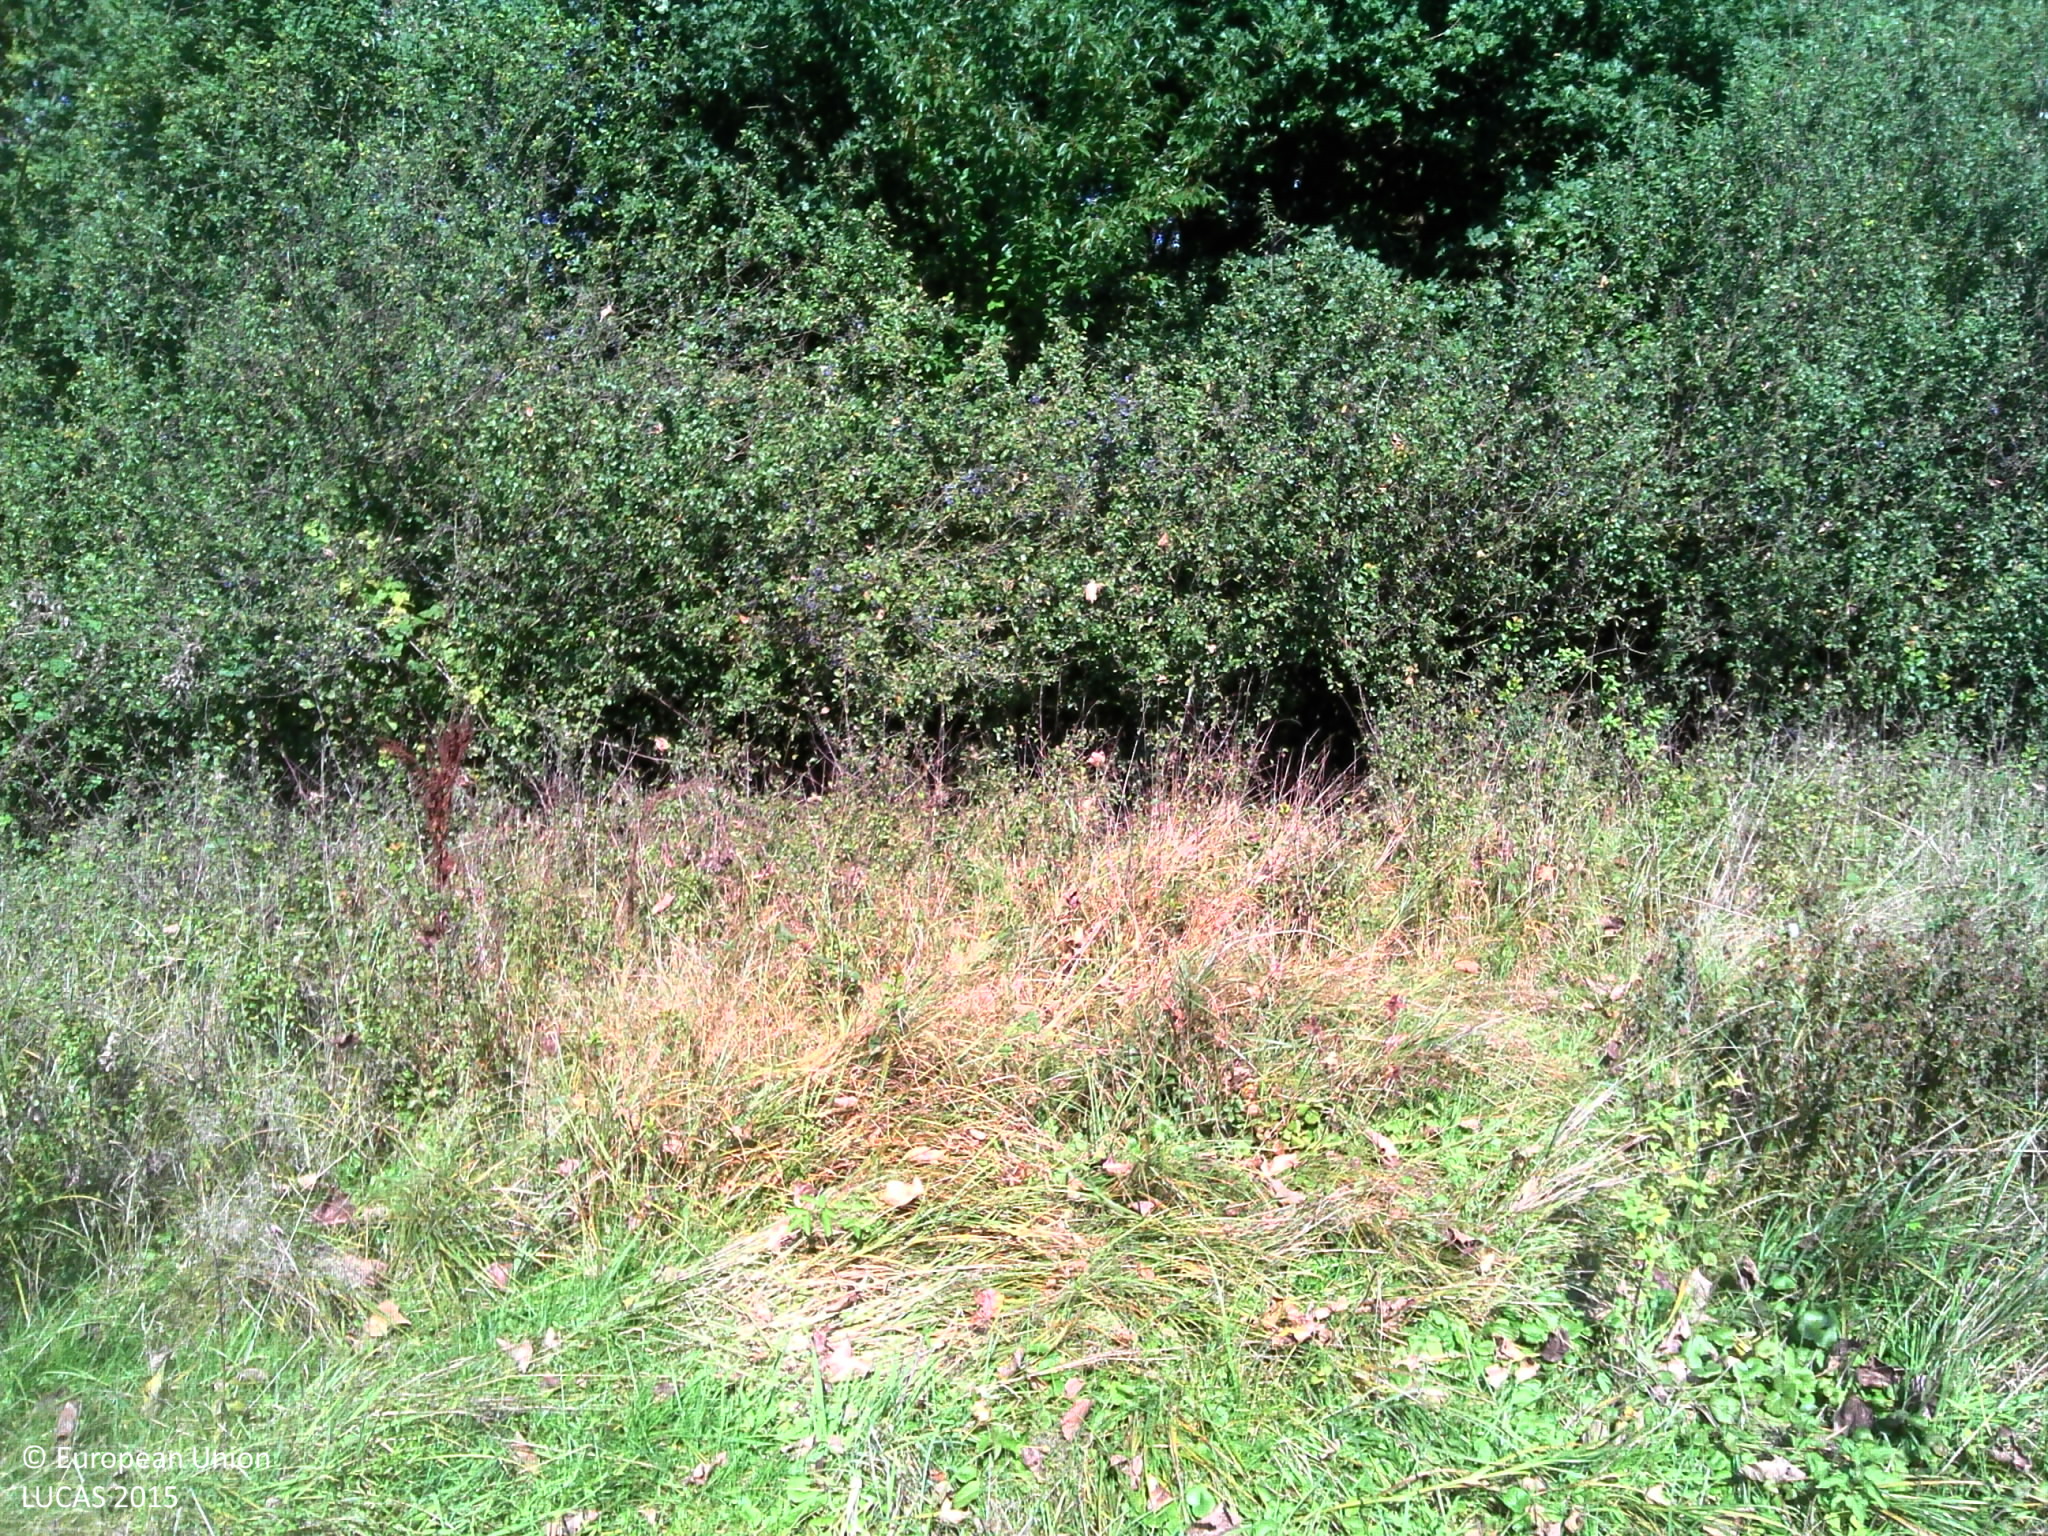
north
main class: Grassland
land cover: Spontaneously vegetated surfaces
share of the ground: > 75 %
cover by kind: herbaceous plants 100 %
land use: Semi-natural and natural areas not in use
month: September
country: BE
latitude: 51.1829
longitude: 4.8035
